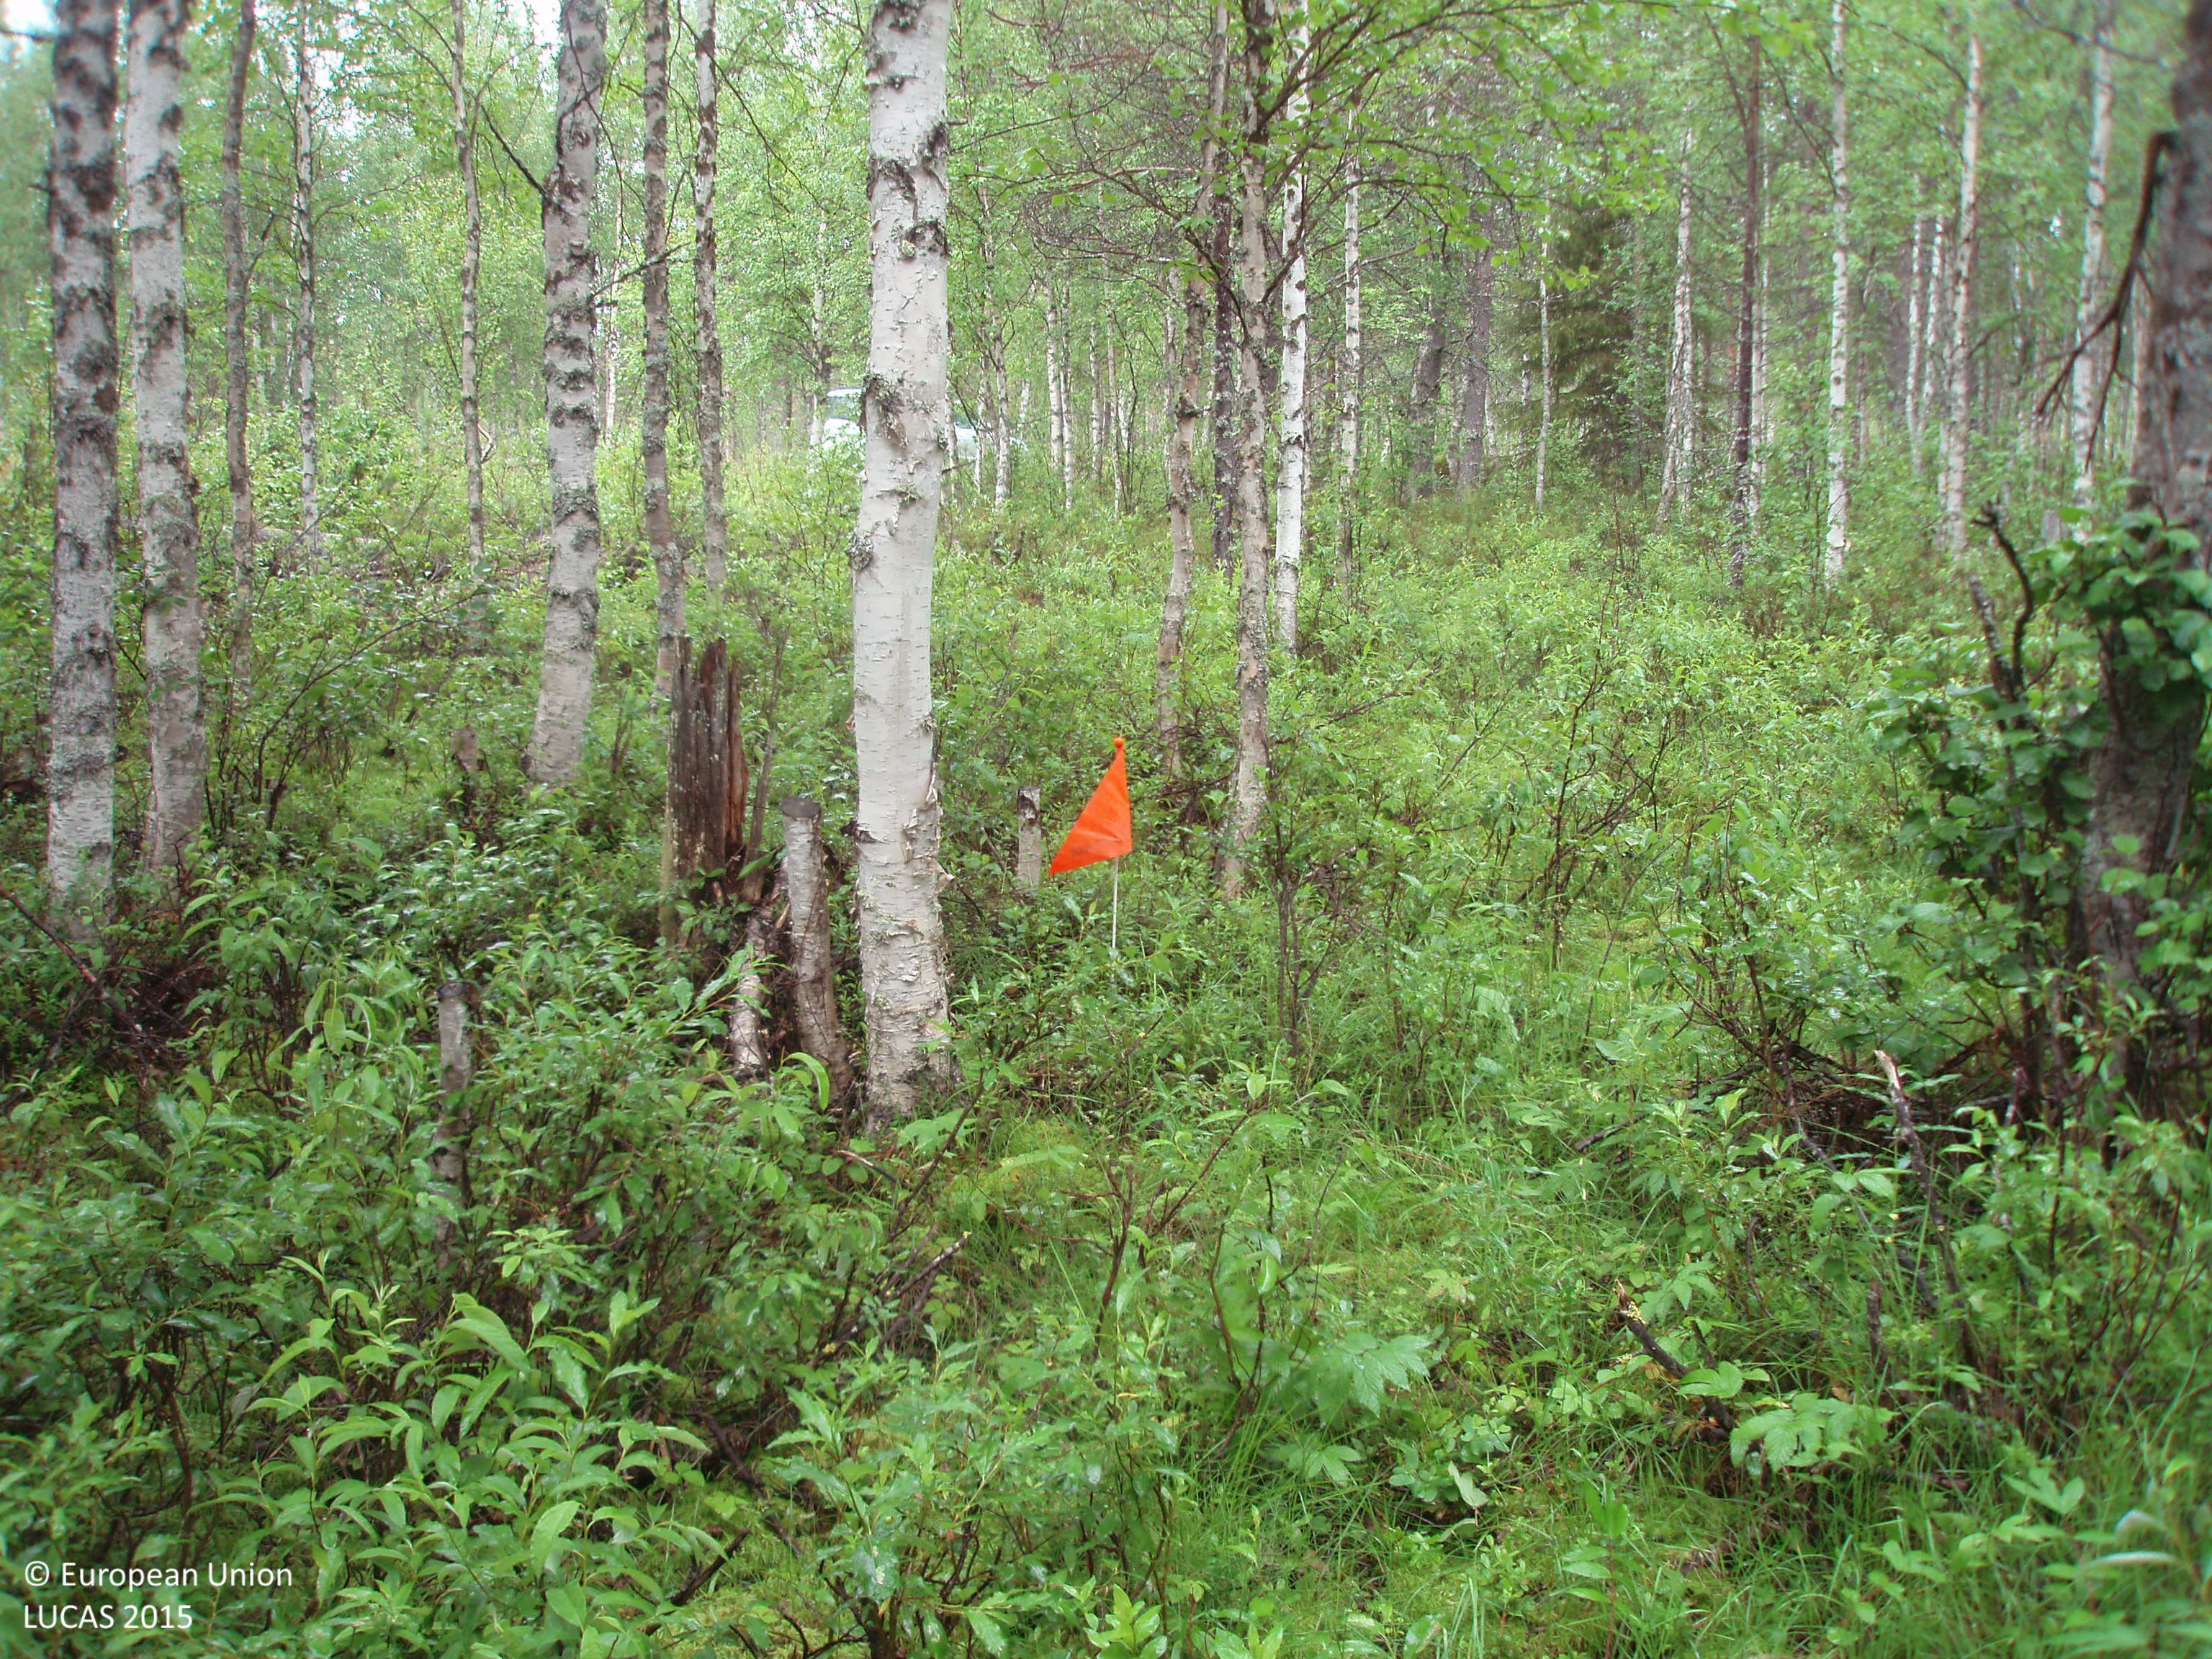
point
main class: Woodland
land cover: Pine dominated mixed woodland
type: boreal forest
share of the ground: > 75 %
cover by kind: broadleaved forest trees 55 %, coniferous forest trees 25 %, shrubs 20 %
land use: Forestry
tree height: > 5 m
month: July
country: FI
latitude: 66.7239
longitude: 27.9255
